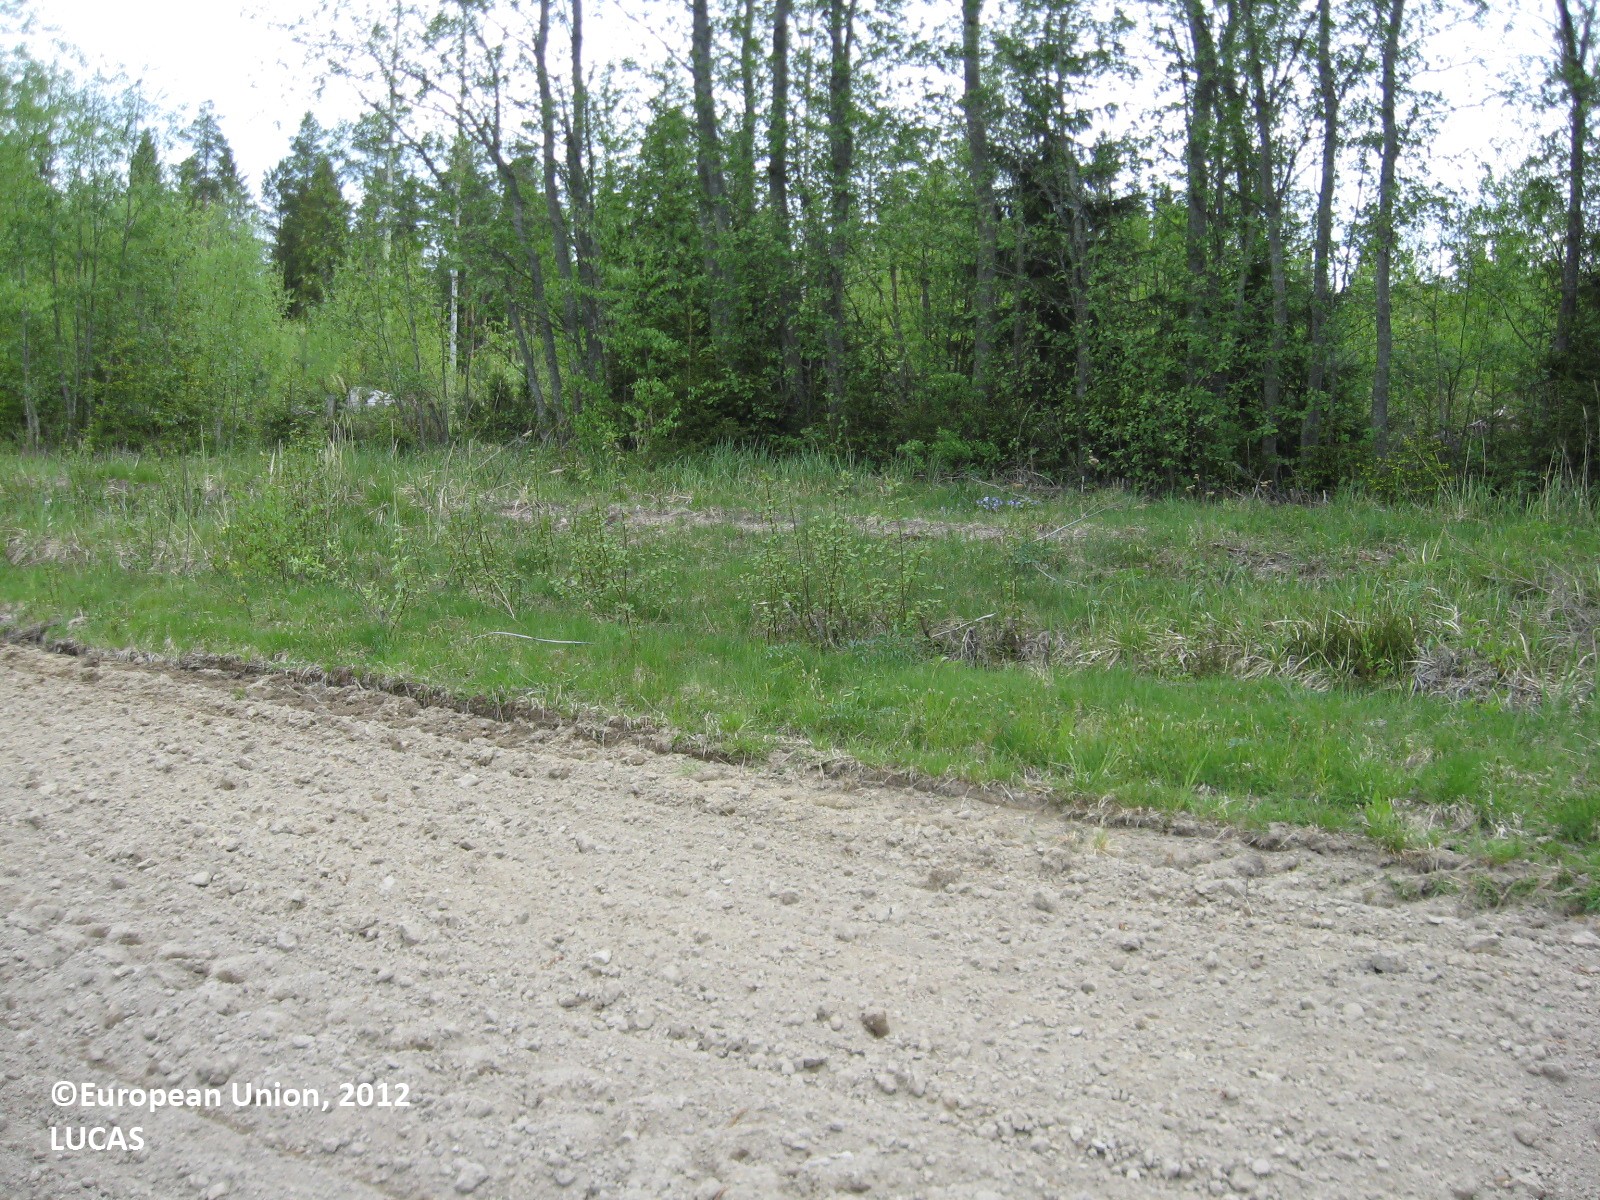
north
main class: Cropland
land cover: Oats
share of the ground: < 10 %
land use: Agriculture (excluding fallow land and kitchen gardens)
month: May
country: FI
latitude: 61.8040
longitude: 22.8343
